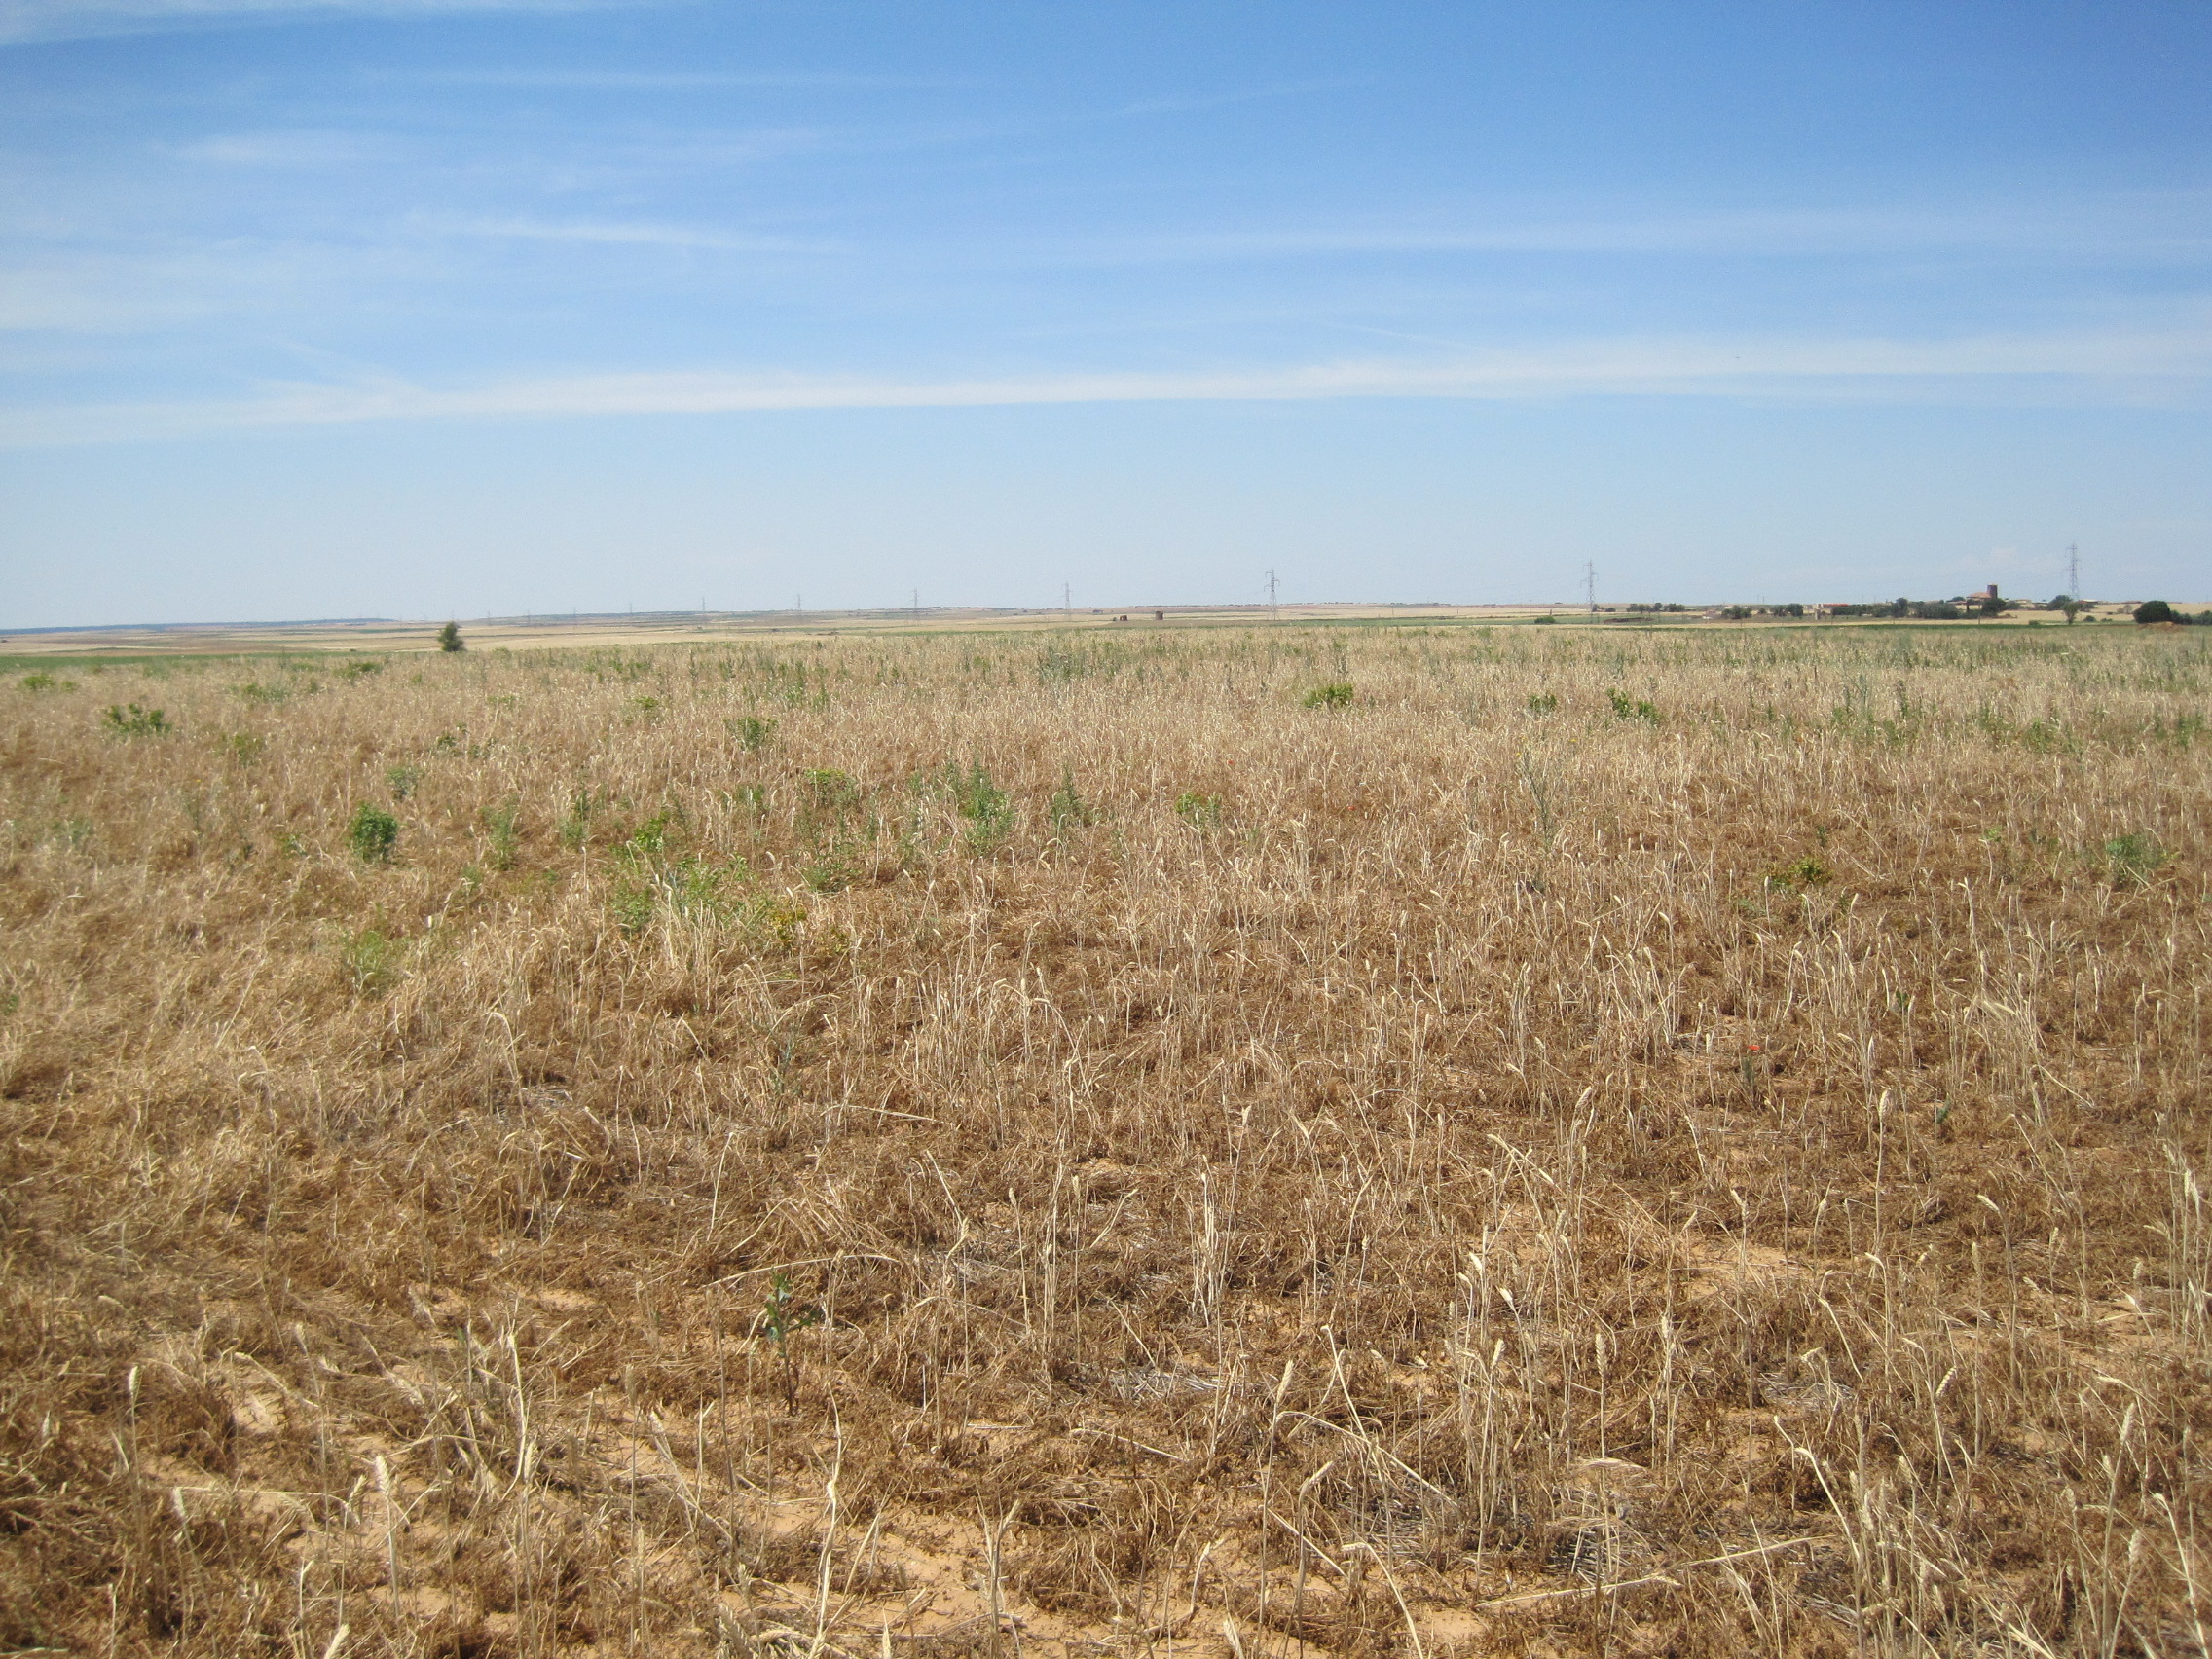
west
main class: Cropland
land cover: Dry pulses
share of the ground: 10 - 25 %
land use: Agriculture (excluding fallow land and kitchen gardens)
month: June
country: ES
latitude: 41.8411
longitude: -5.2430
